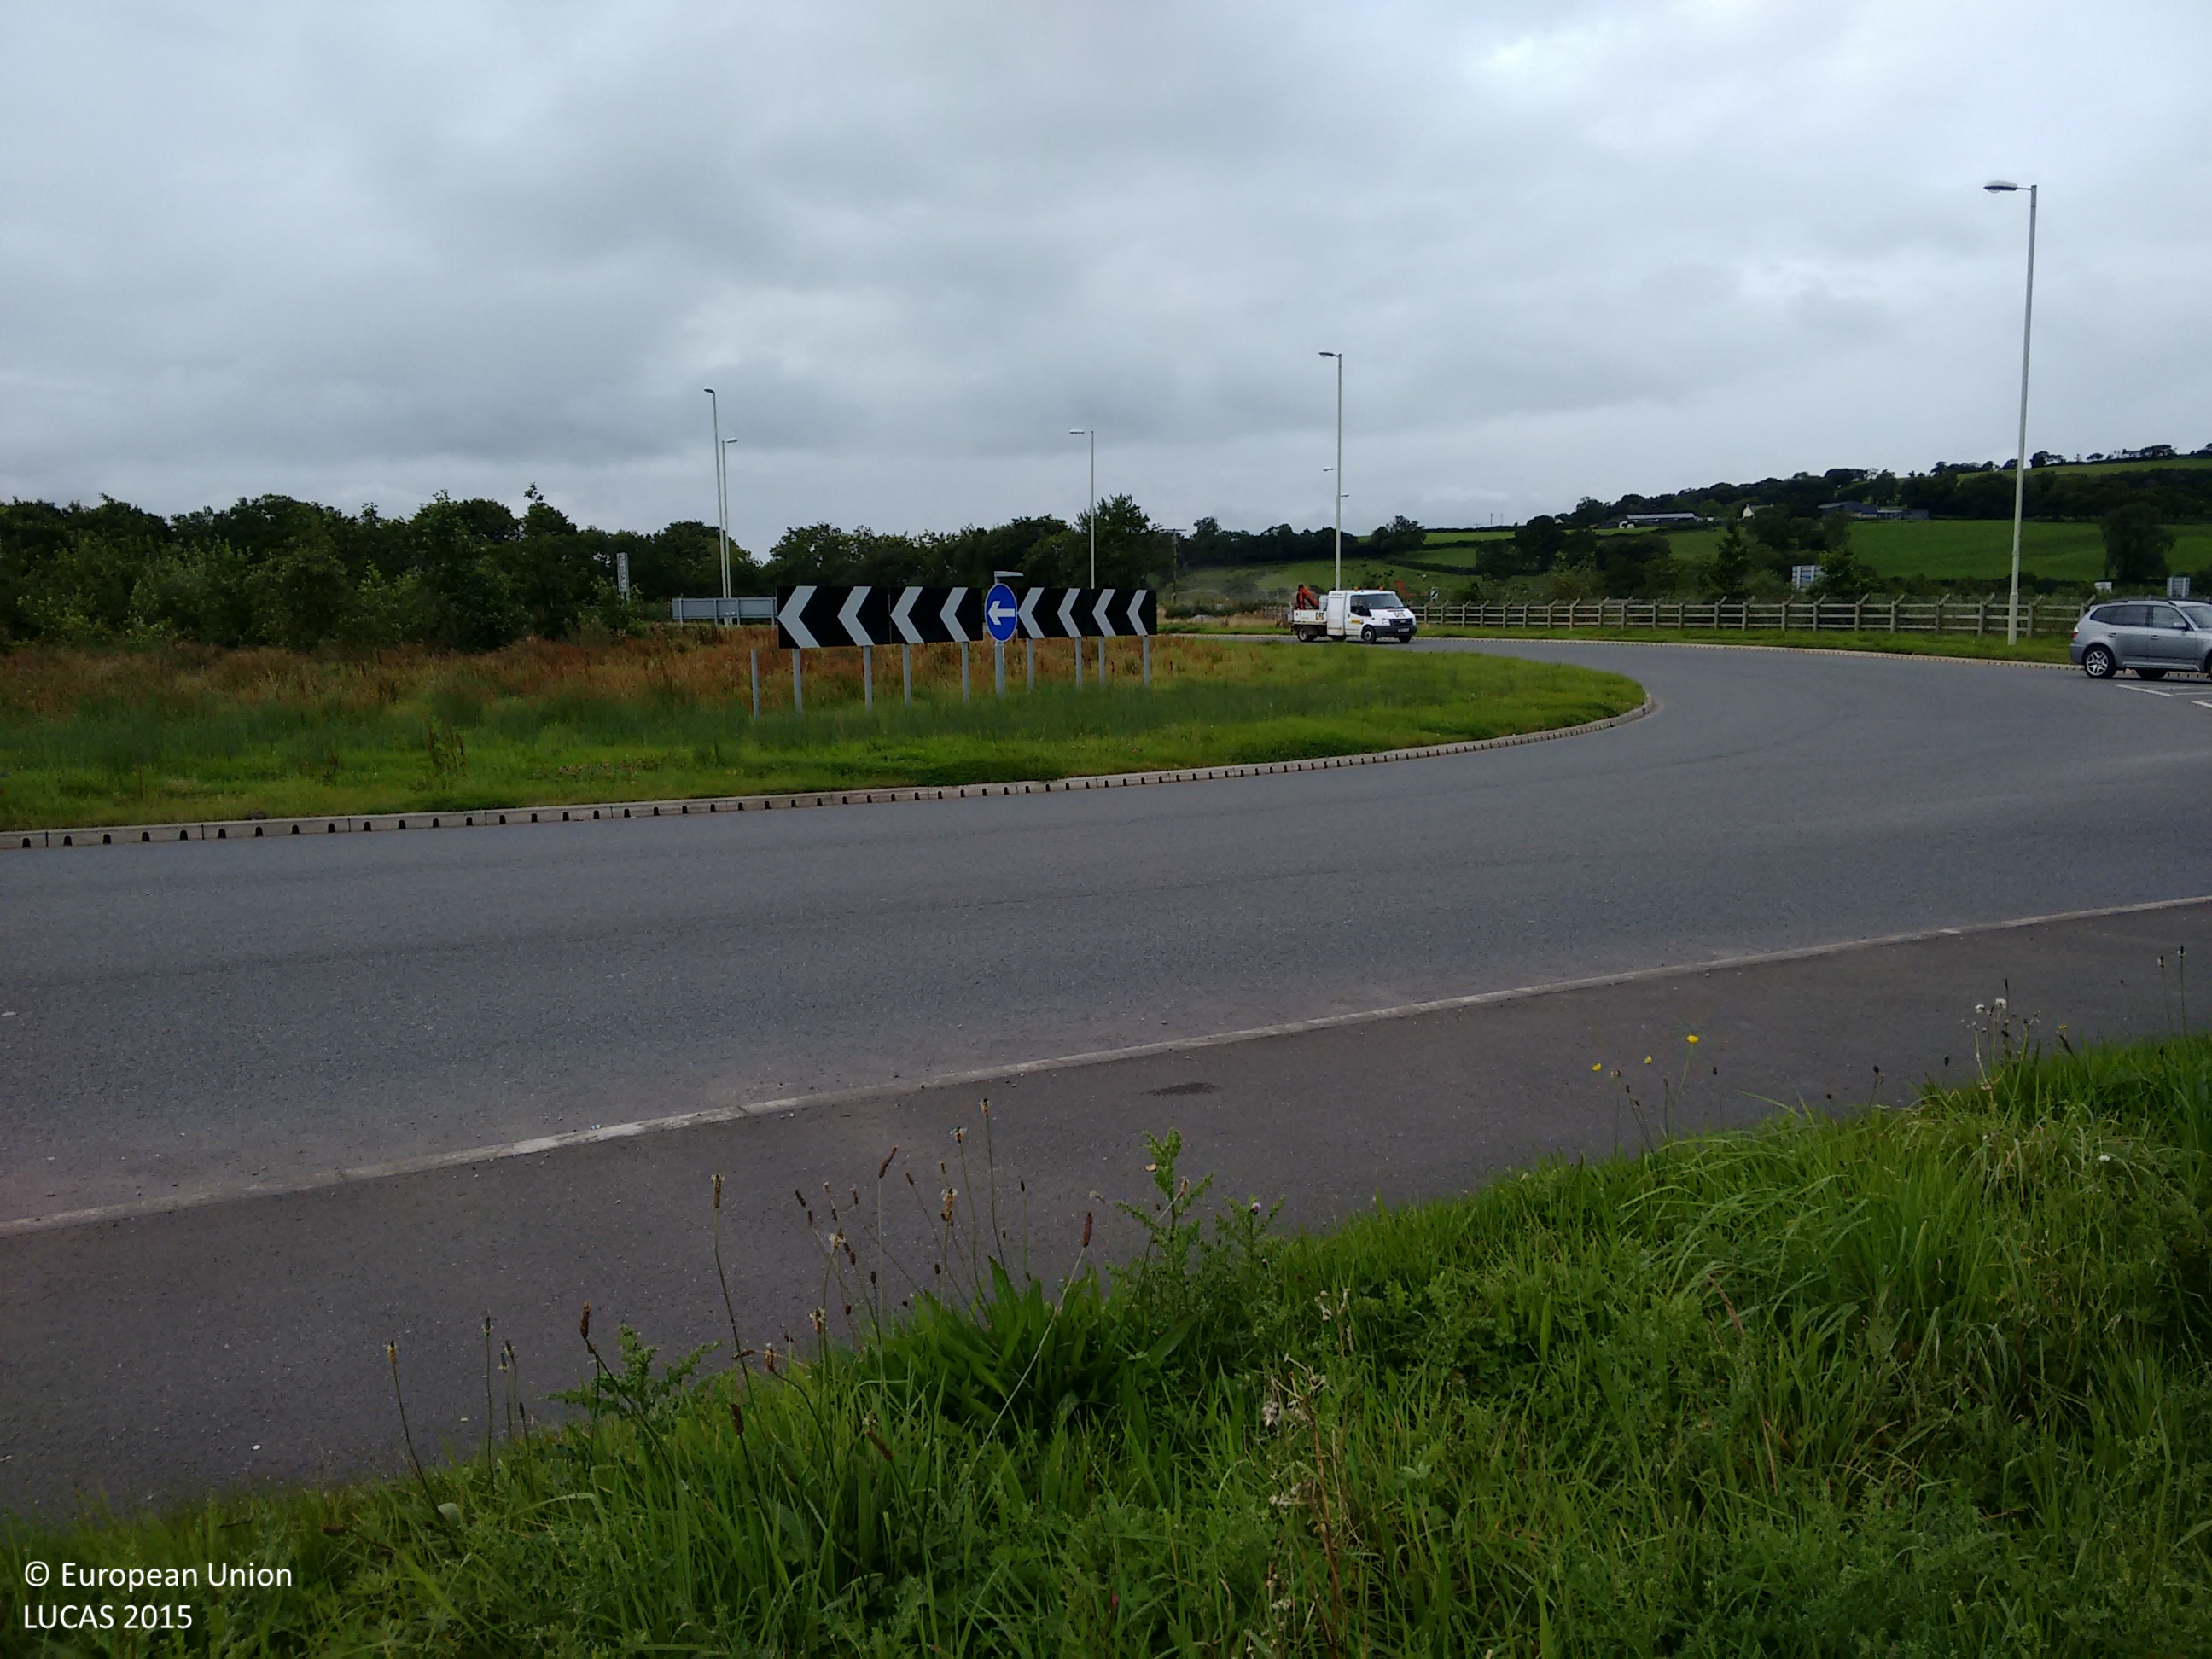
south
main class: Grassland
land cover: Grassland without tree/shrub cover
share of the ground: > 75 %
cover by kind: herbaceous plants 100 %
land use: Road transport
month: September
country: GB
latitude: 51.5479
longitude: -3.3339
